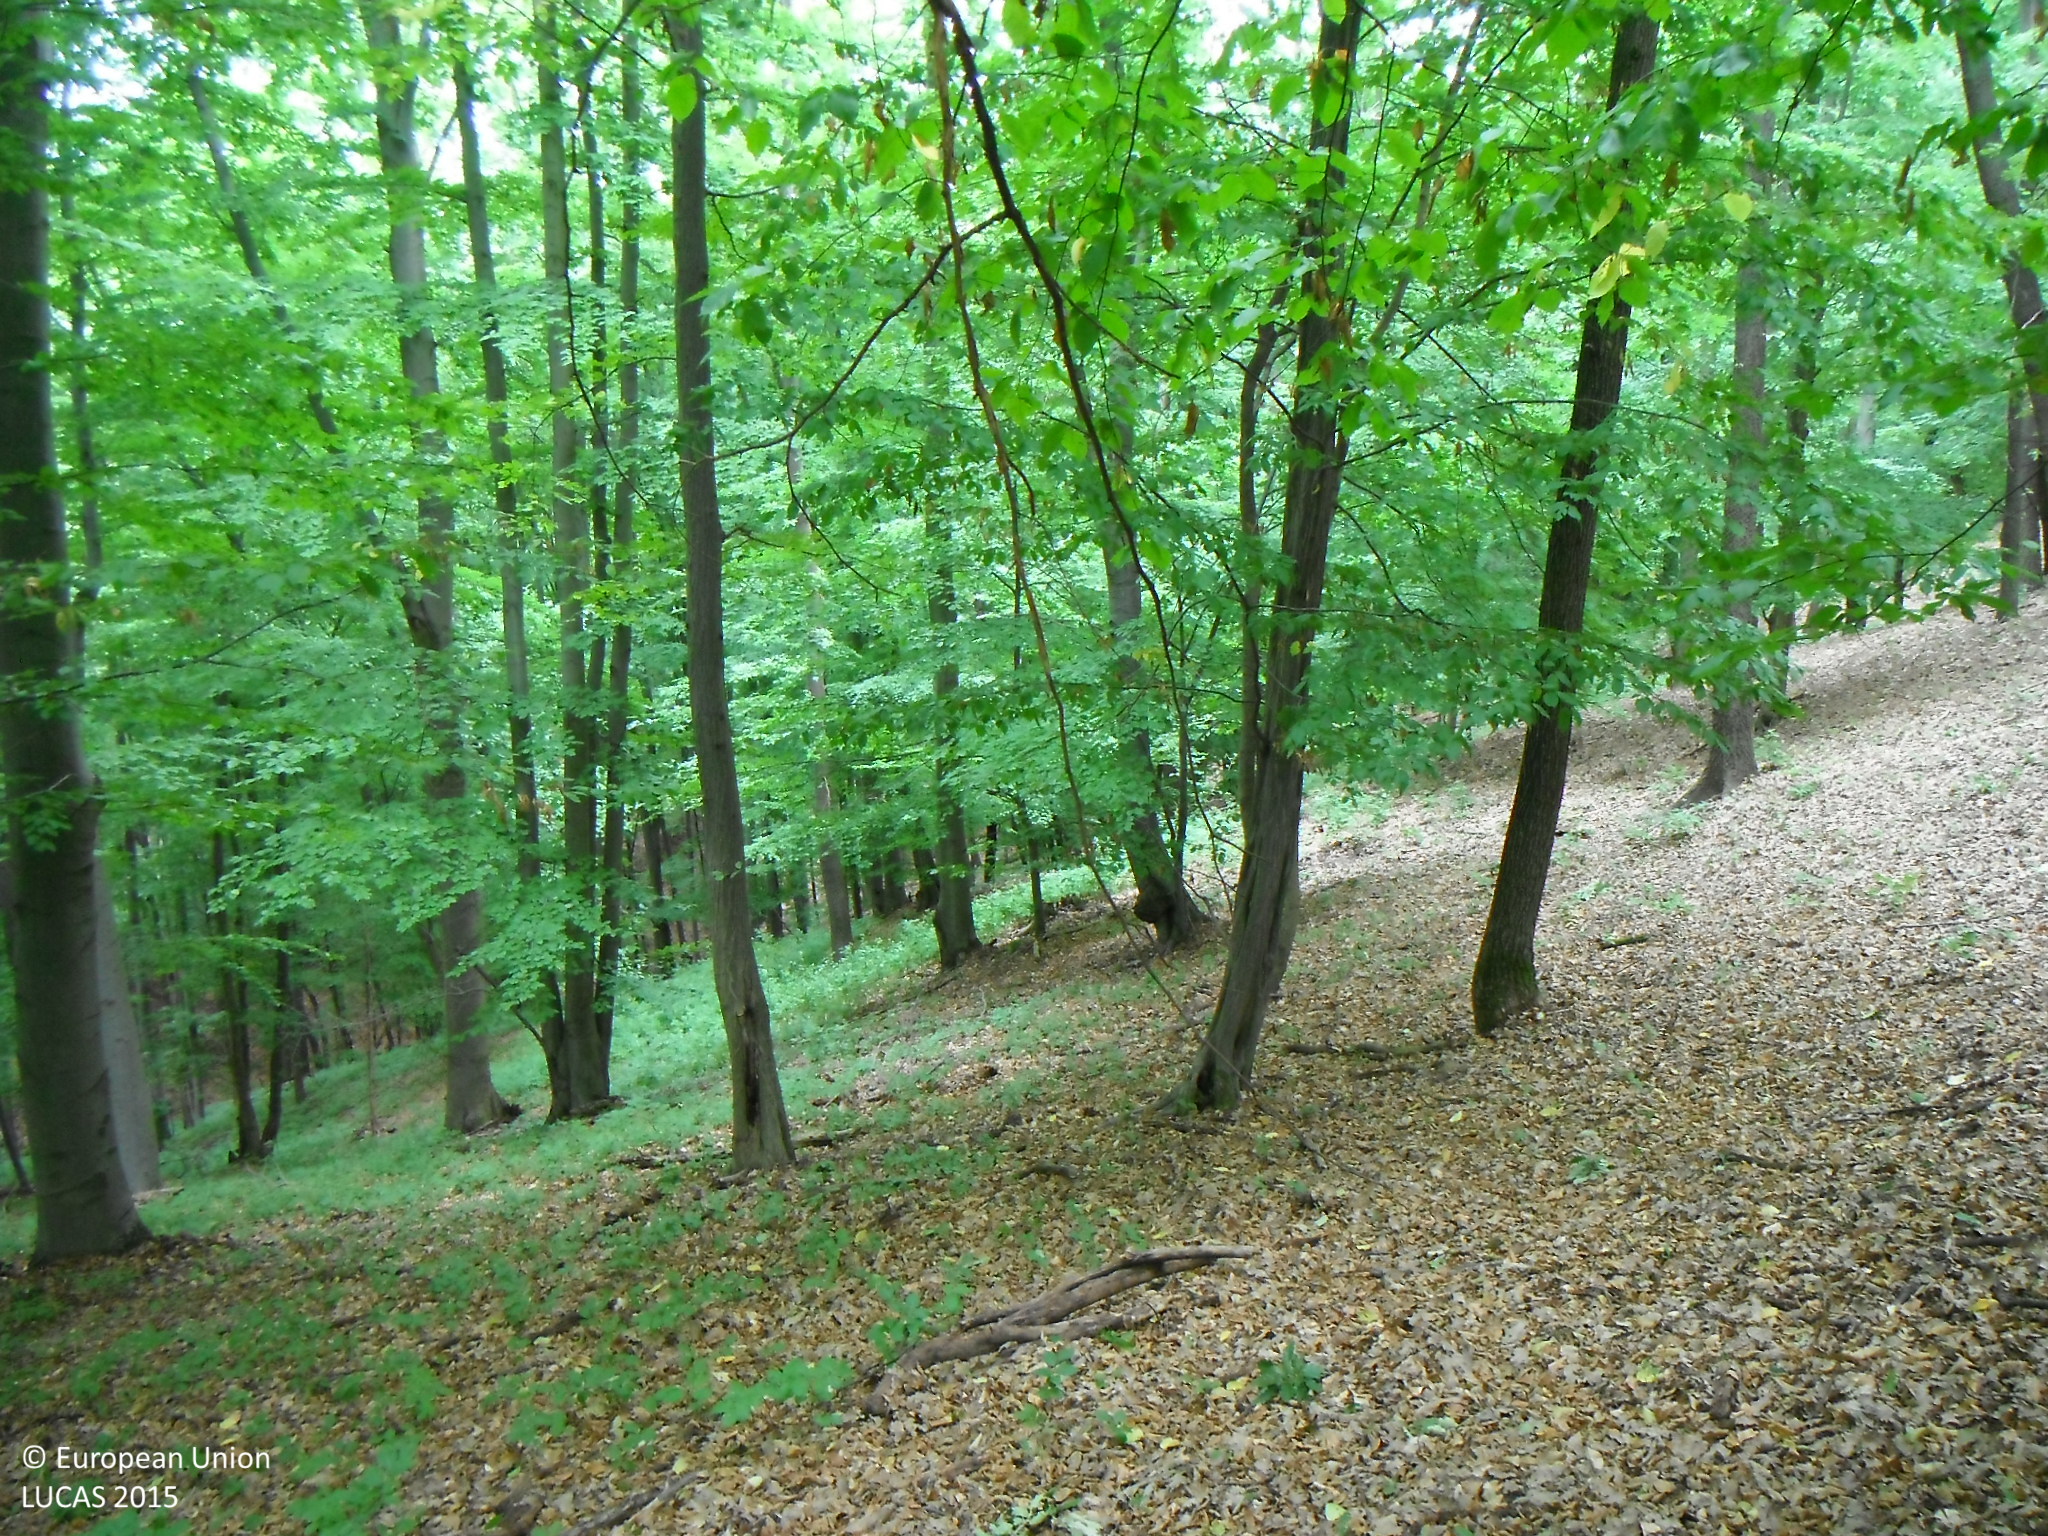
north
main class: Woodland
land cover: Broadleaved woodland
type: mesophytic deciduous forest
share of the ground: > 75 %
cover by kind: broadleaved forest trees 100 %
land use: Forestry
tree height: > 5 m
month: July
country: SK
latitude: 48.1972
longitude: 19.8620
